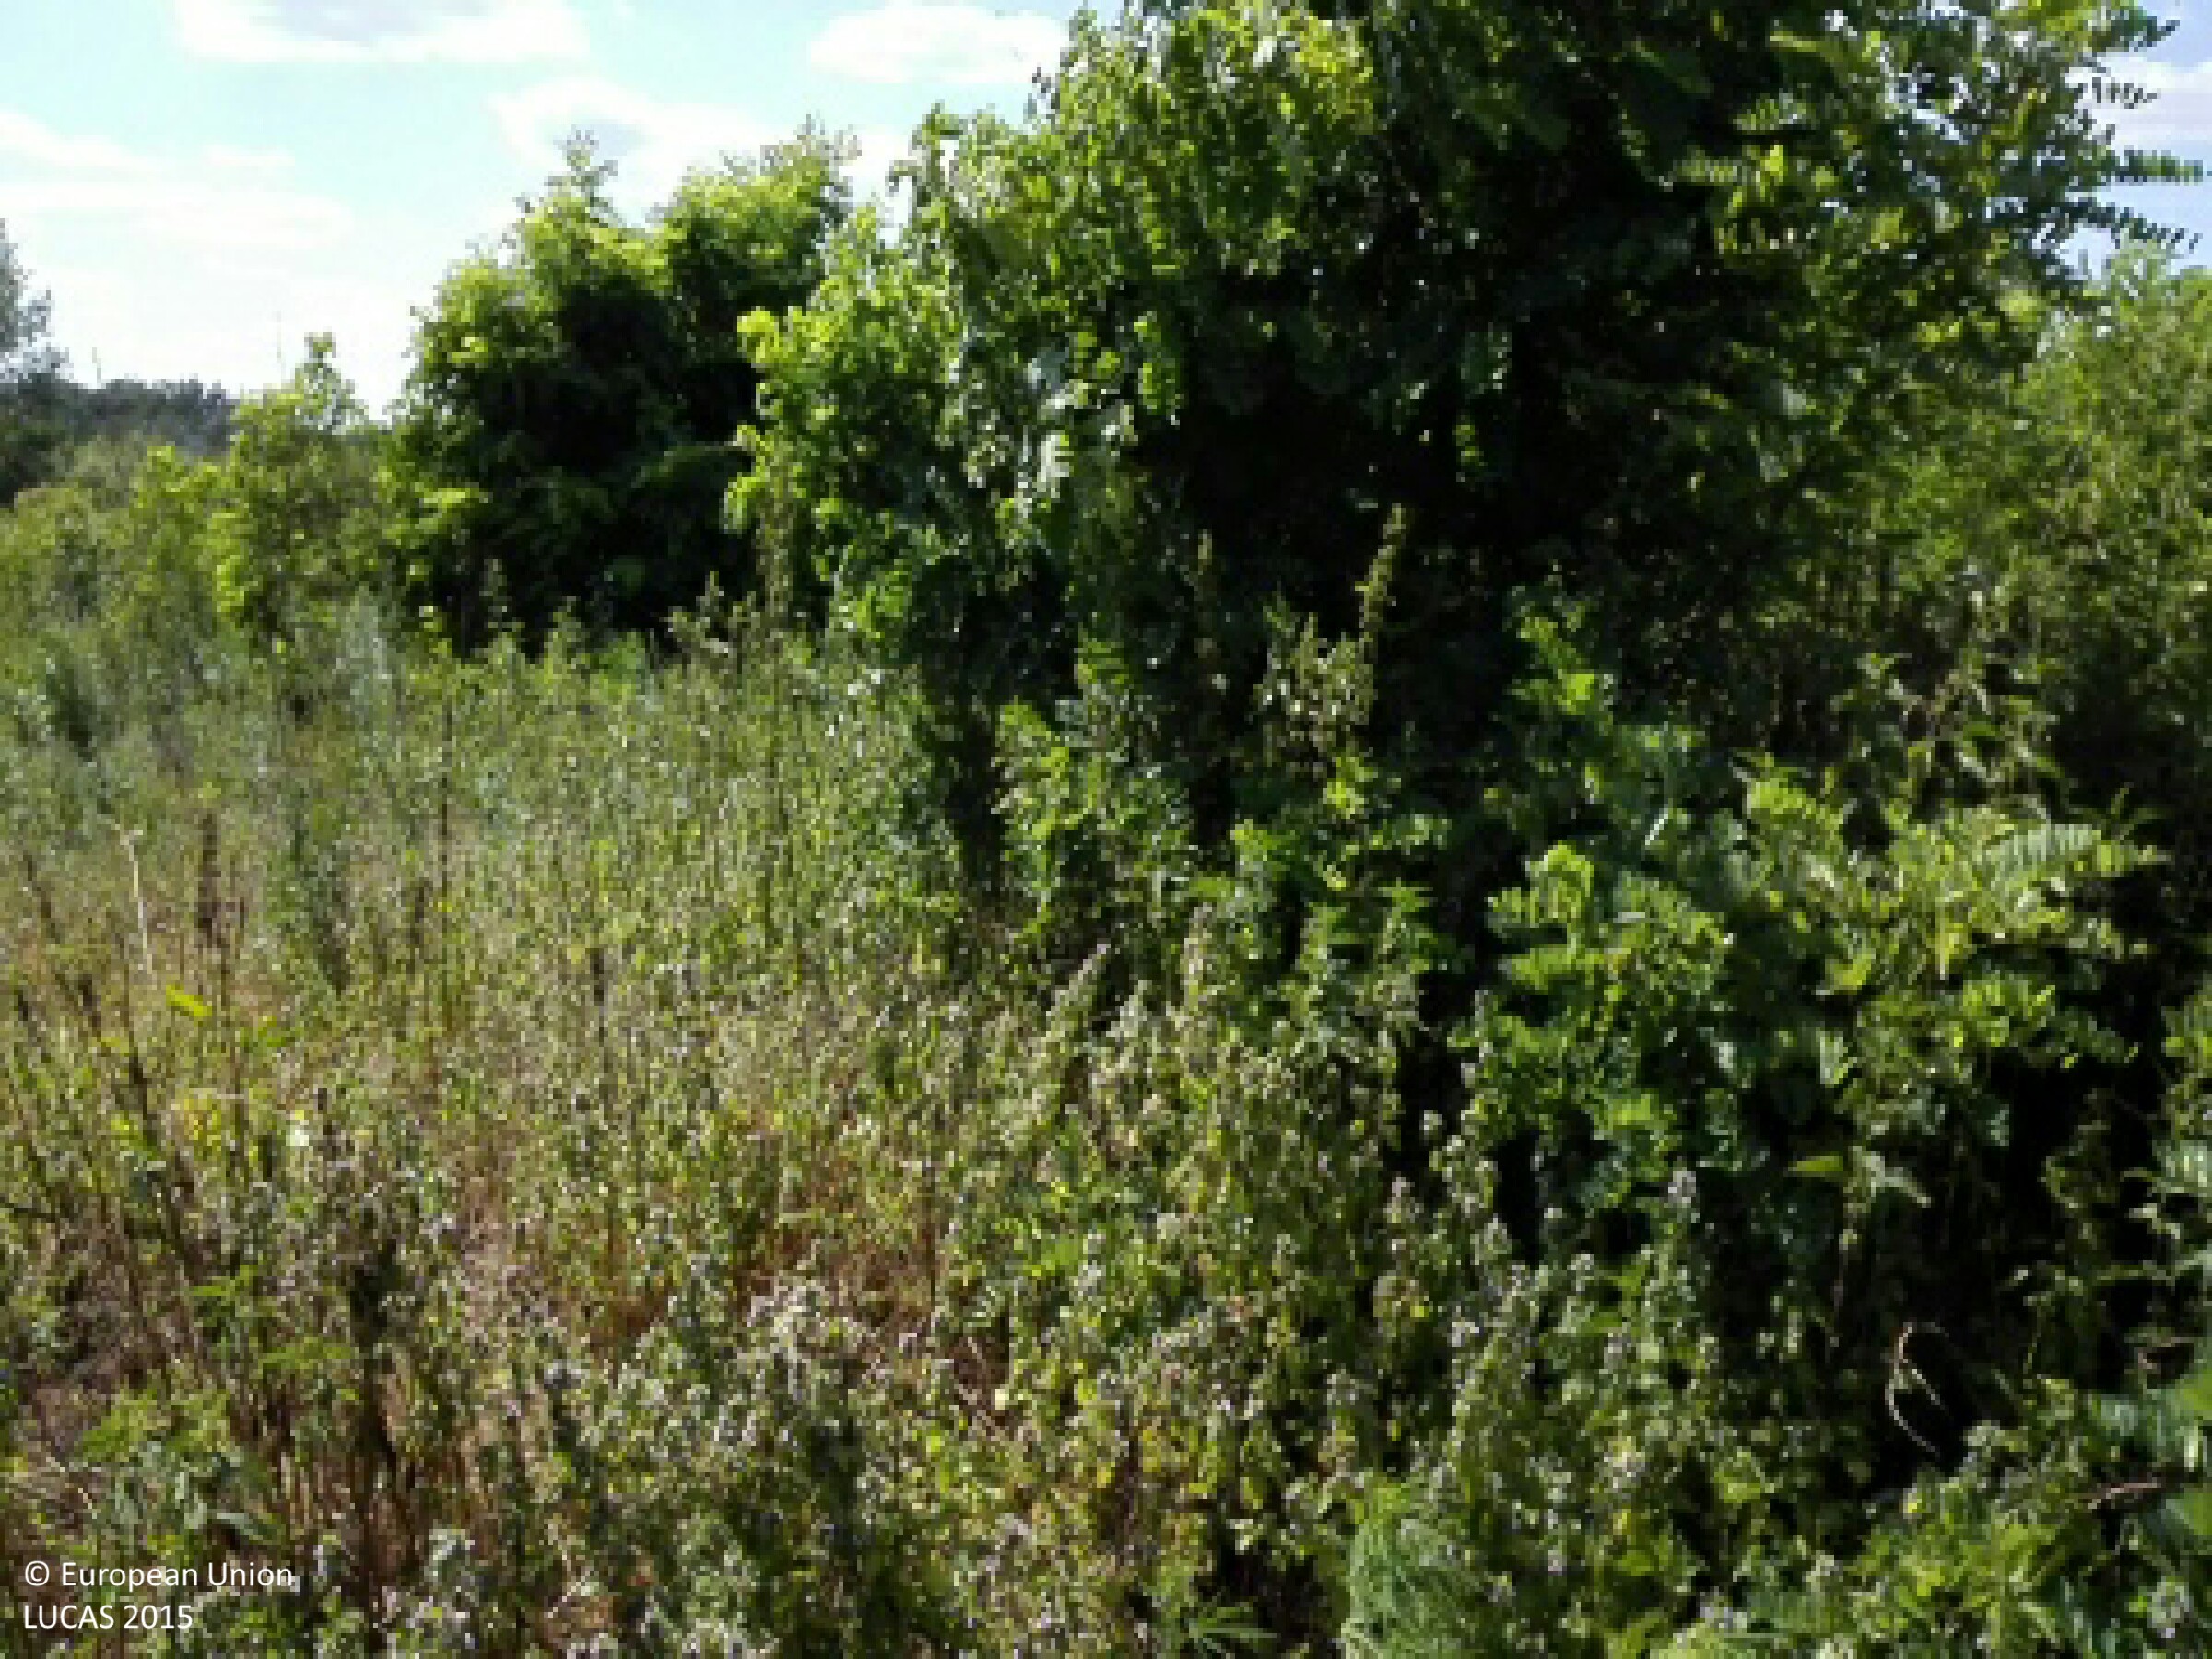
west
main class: Woodland
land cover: Broadleaved woodland
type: mesophytic deciduous forest
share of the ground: 10 - 25 %
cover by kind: herbaceous plants 80 %, broadleaved forest trees 15 %, shrubs 5 %
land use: Semi-natural and natural areas not in use
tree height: > 5 m
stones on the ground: < 10 %
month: July
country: HU
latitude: 47.6652
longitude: 21.7525
